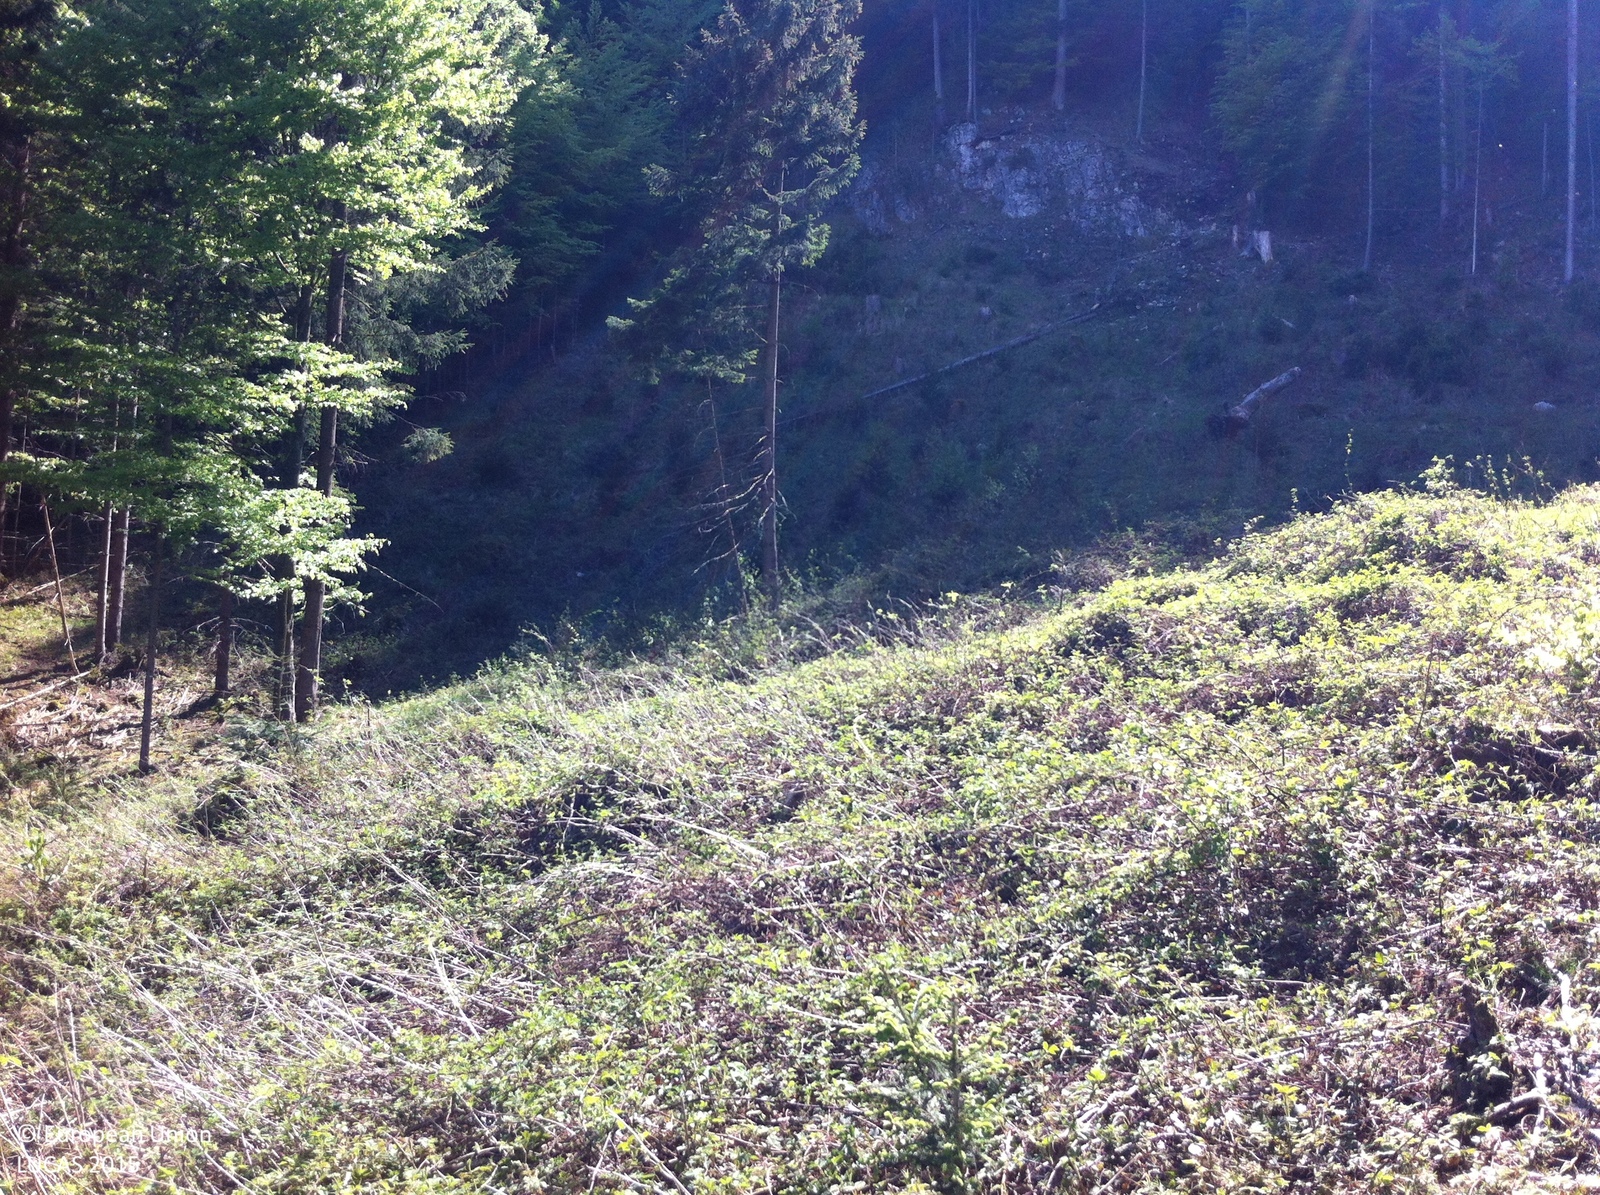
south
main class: Shrubland
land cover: Shrubland with sparse tree cover
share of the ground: > 75 %
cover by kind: unconsolidated bare surface 80 %, shrubs 10 %, coniferous forest trees 5 %, herbaceous plants 5 %
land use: Forestry
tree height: < 5 m
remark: Clear cut
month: May
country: AT
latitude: 47.3994
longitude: 11.7608
